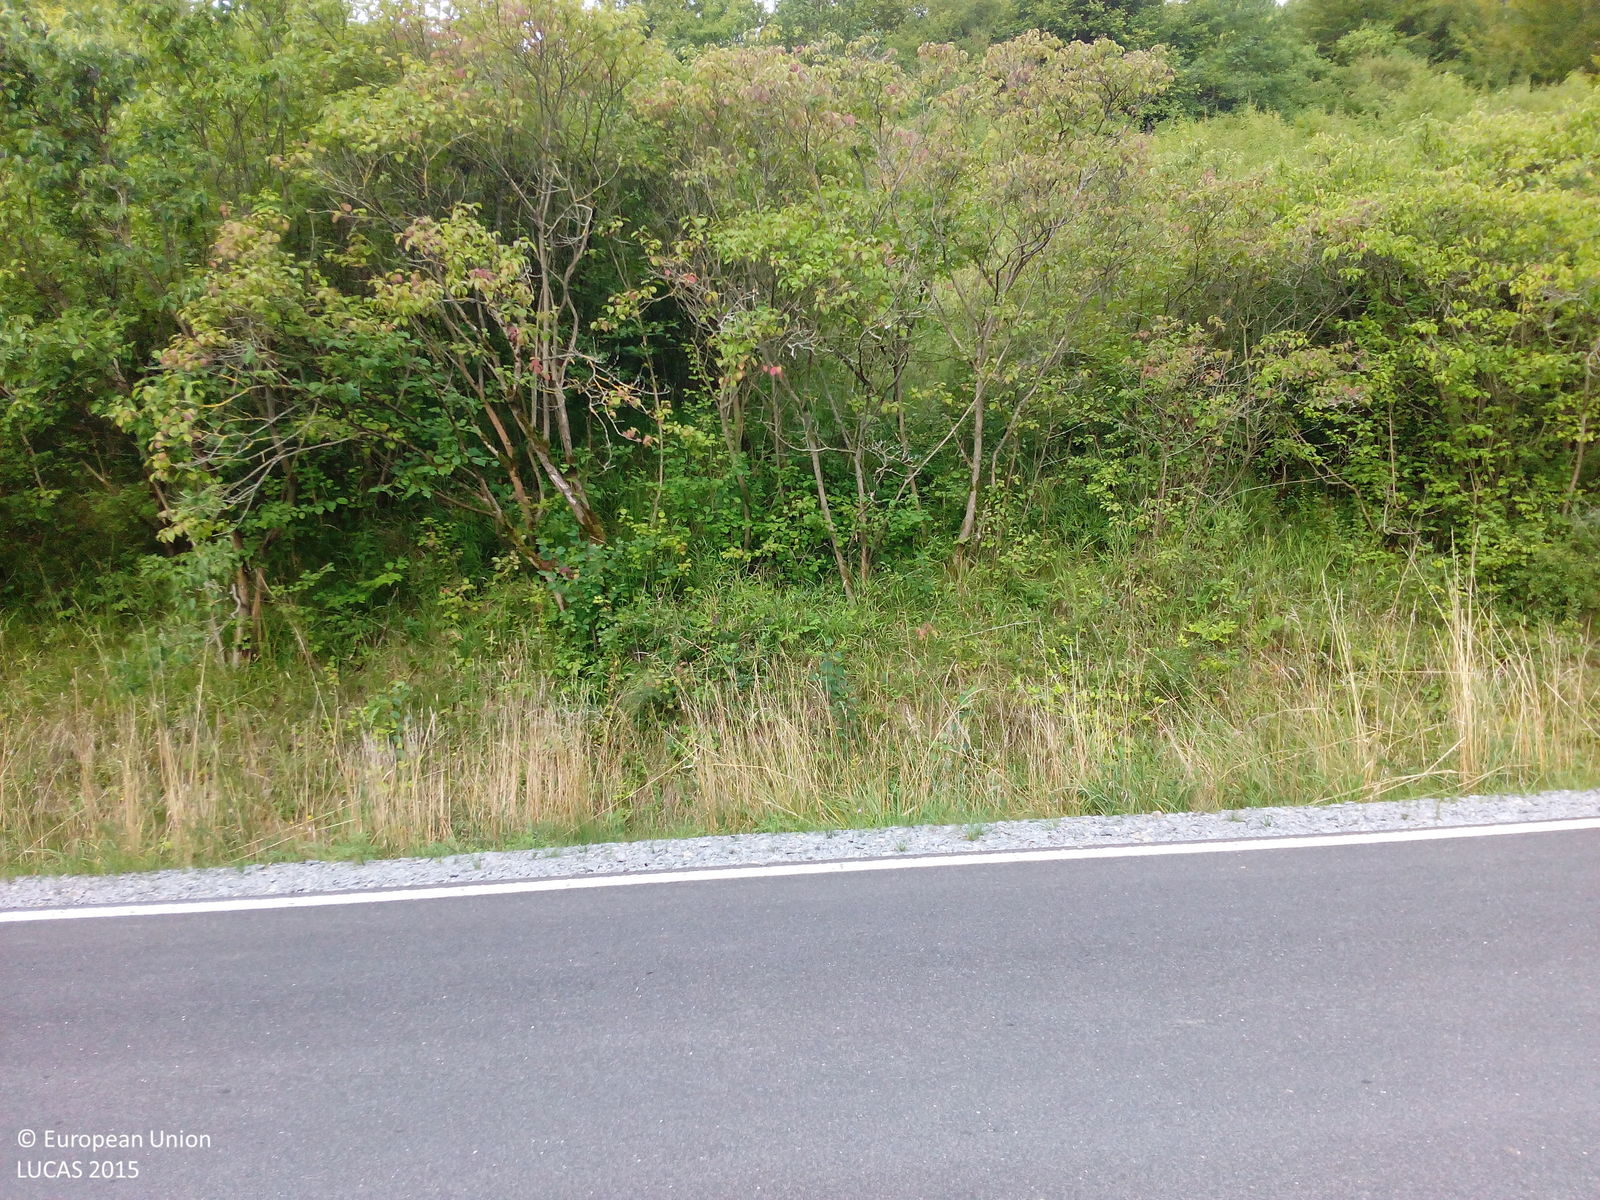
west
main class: Grassland
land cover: Grassland without tree/shrub cover
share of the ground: > 75 %
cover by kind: herbaceous plants 95 %, shrubs 5 %
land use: Agriculture (excluding fallow land and kitchen gardens)
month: August
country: DE
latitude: 51.1368
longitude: 10.2715
